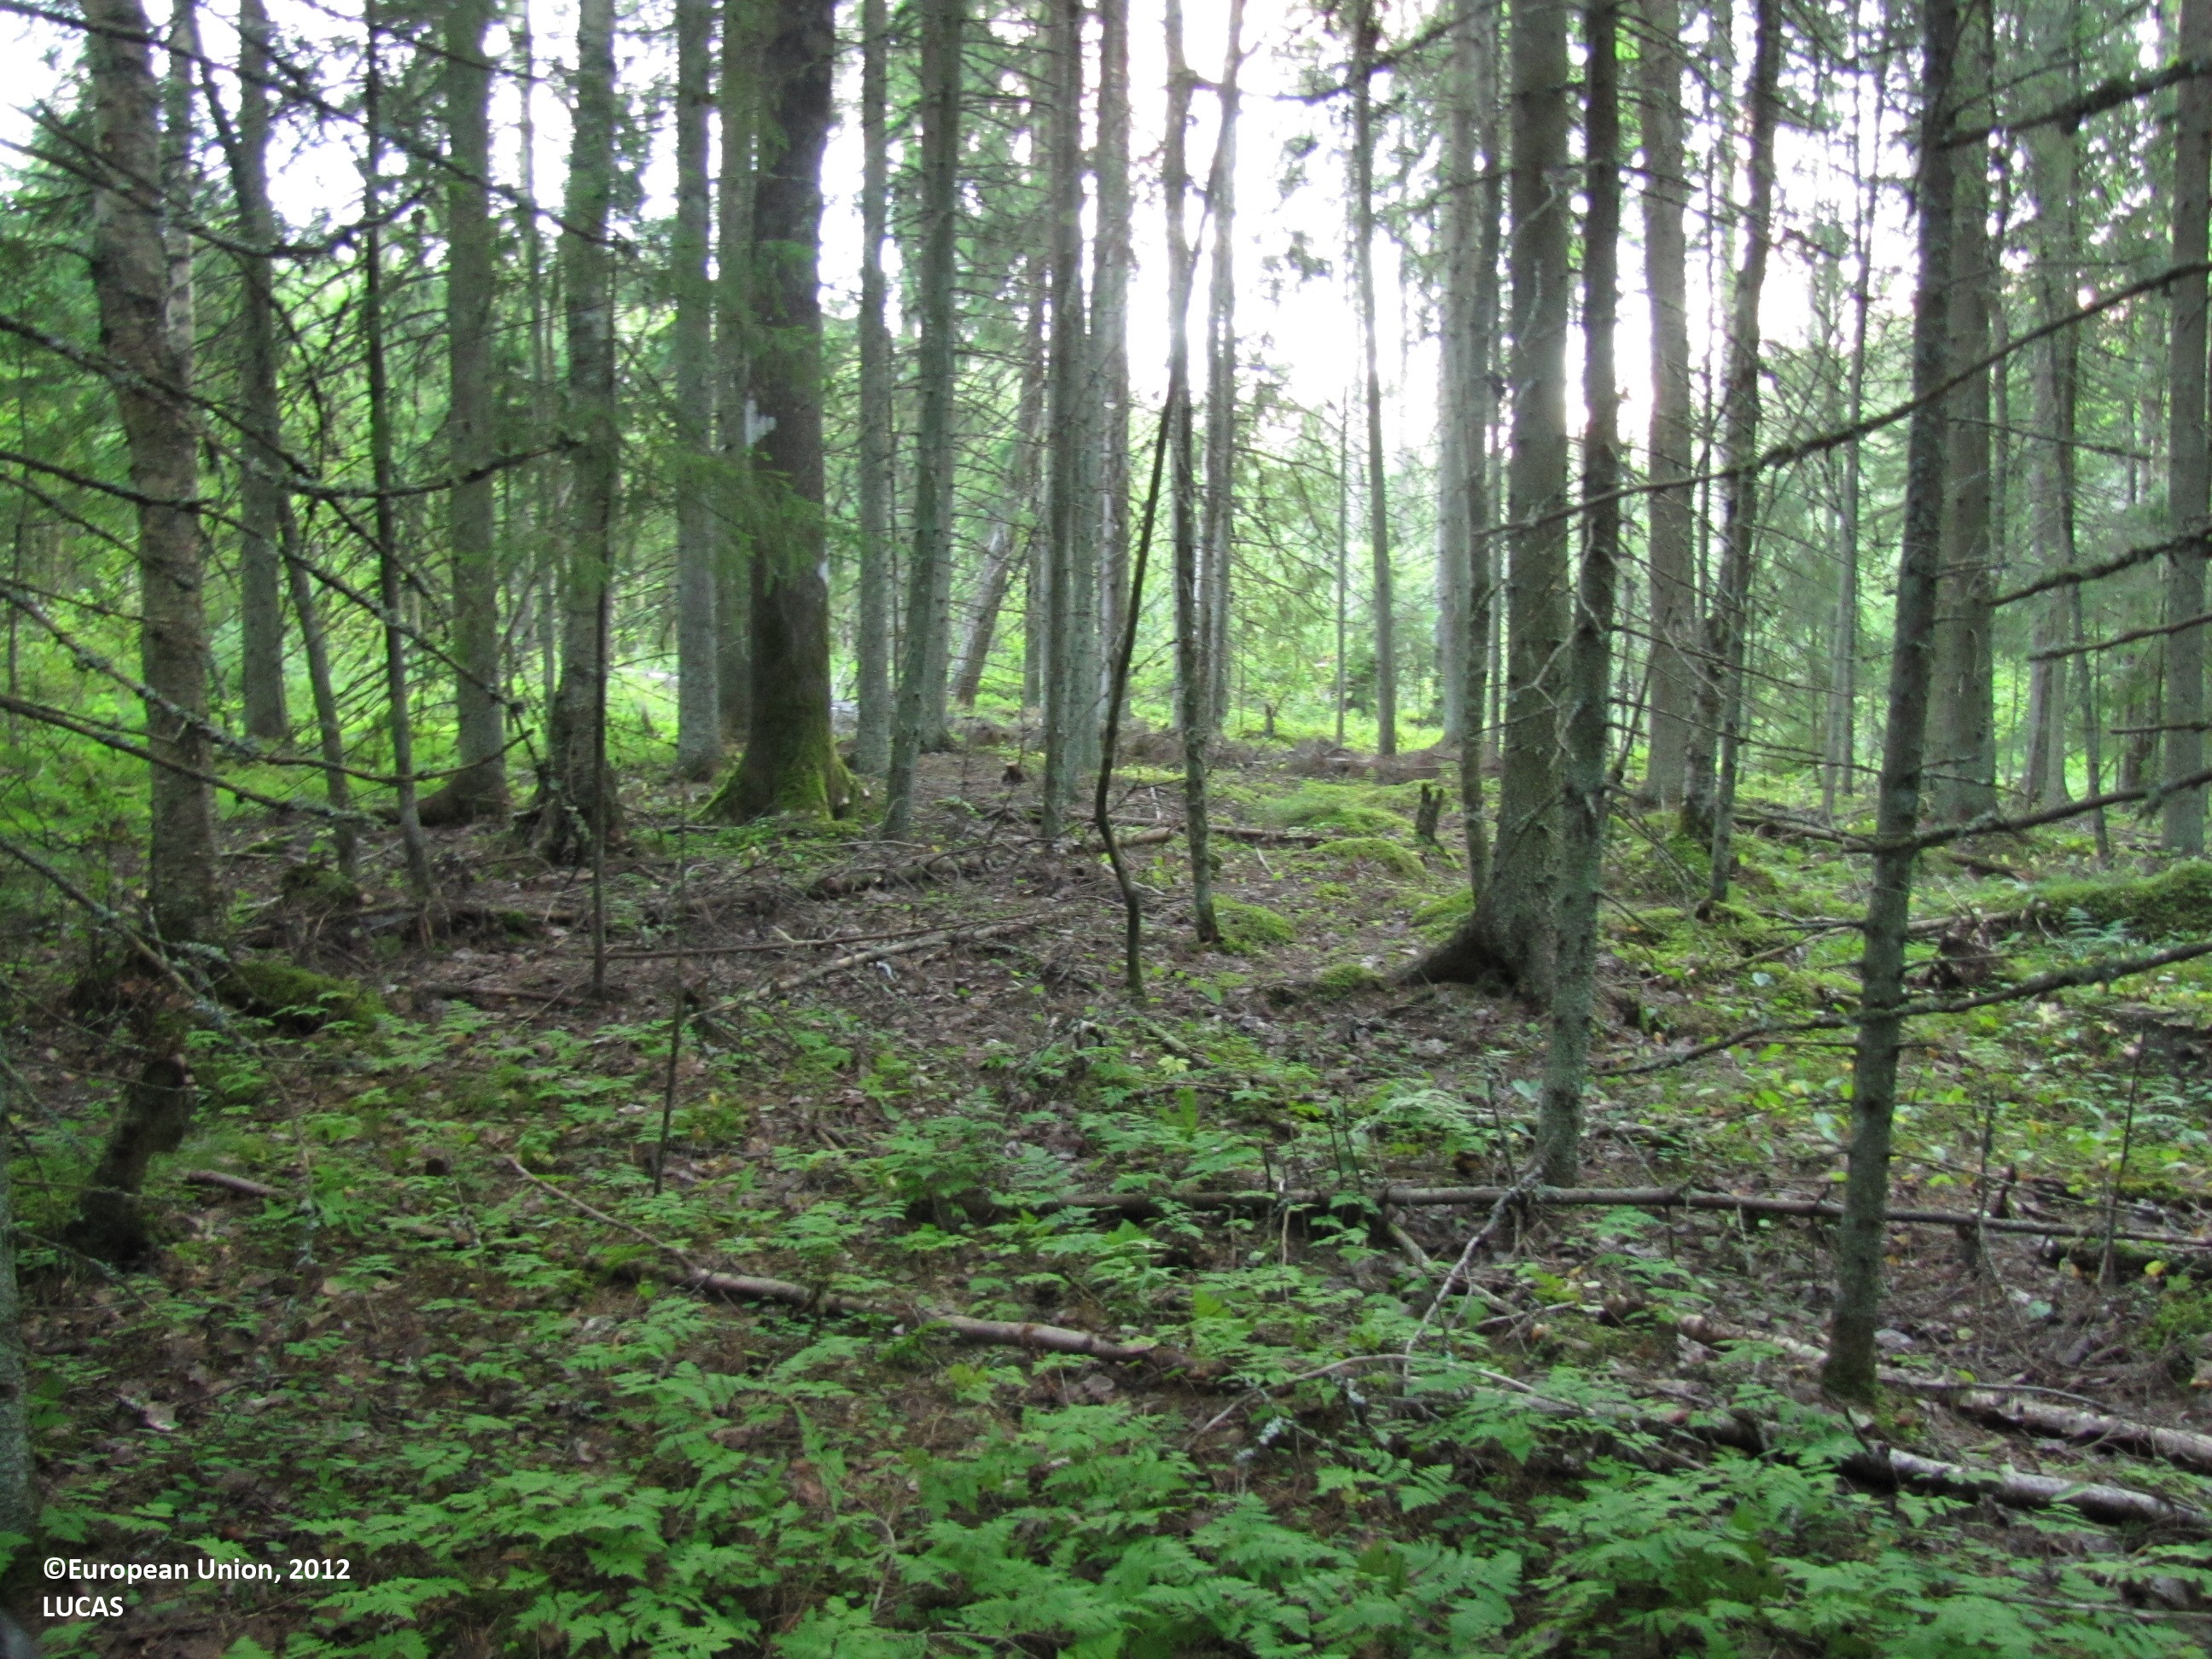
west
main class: Woodland
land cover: Spruce dominated coniferous woodland
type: boreal forest
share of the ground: > 75 %
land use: Forestry
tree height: > 5 m
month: August
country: FI
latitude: 61.7732
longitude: 22.9756
